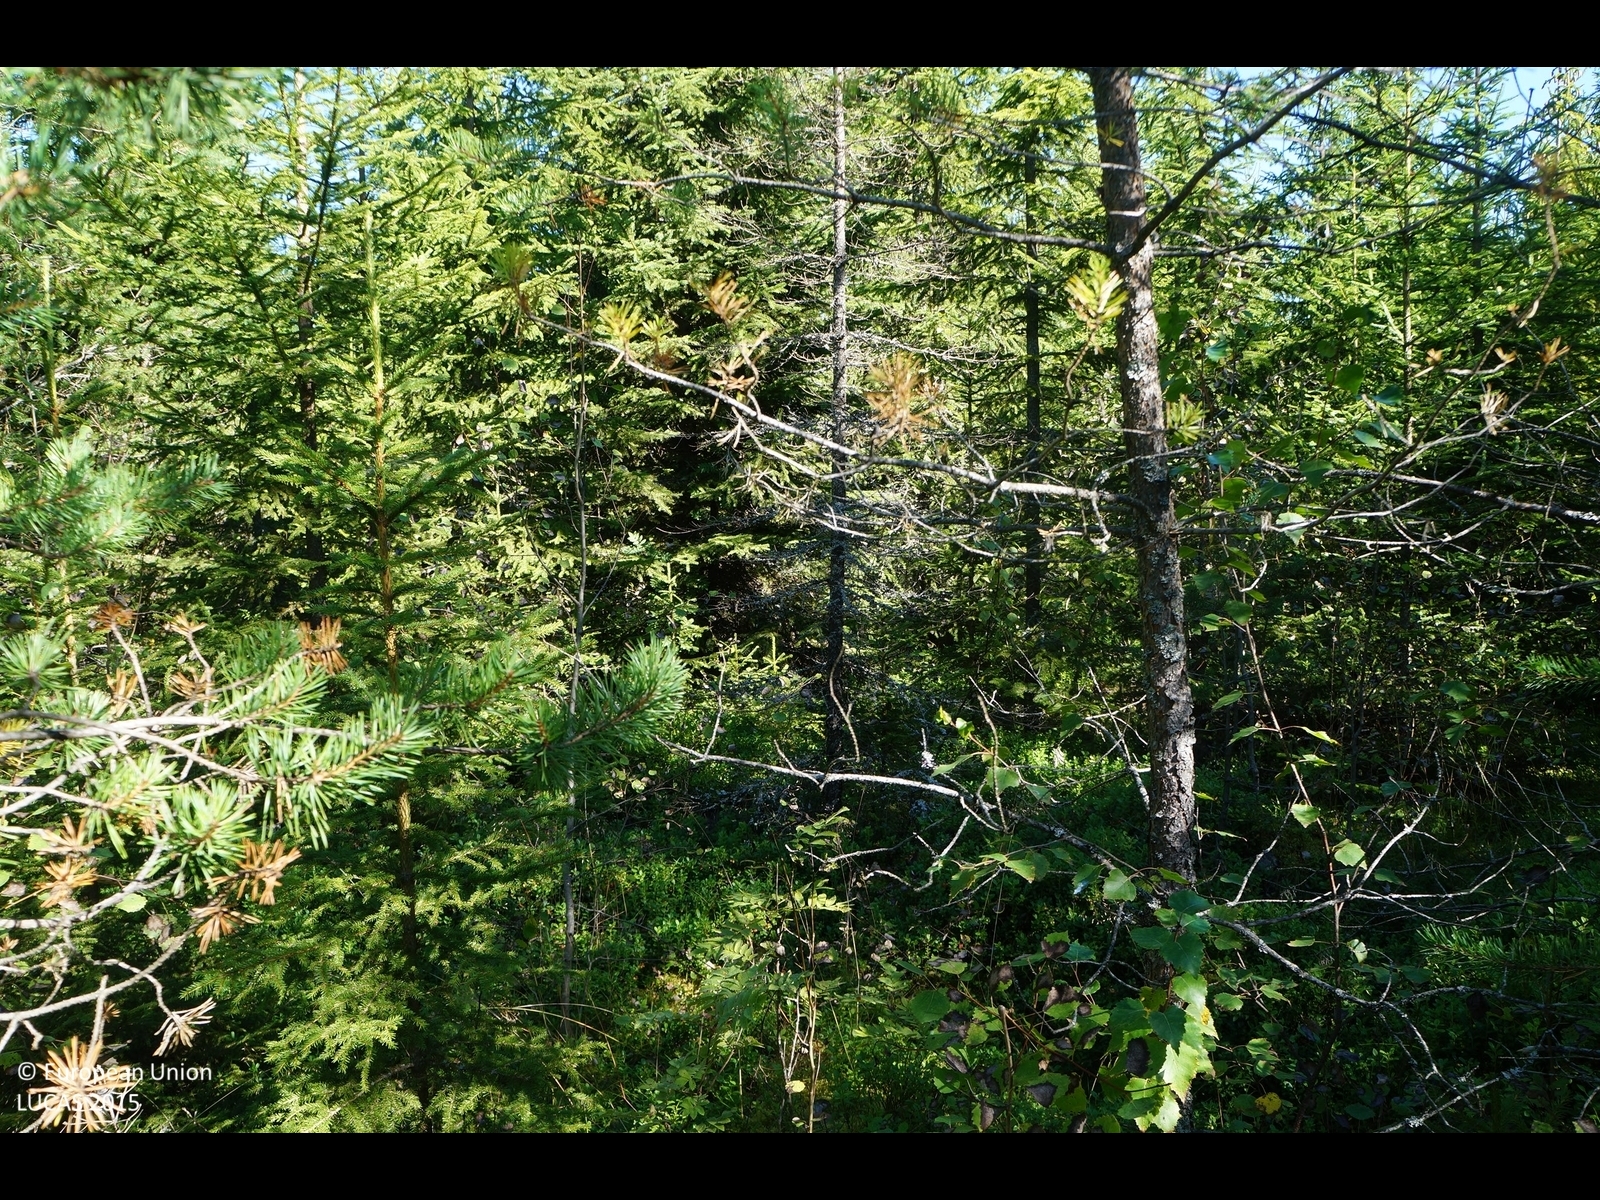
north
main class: Woodland
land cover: Other mixed woodland
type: boreal forest
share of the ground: 50 - 75 %
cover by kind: coniferous forest trees 50 %, shrubs 30 %, broadleaved forest trees 20 %
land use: Forestry
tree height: > 5 m
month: August
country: FI
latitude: 63.7362
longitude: 22.9539
